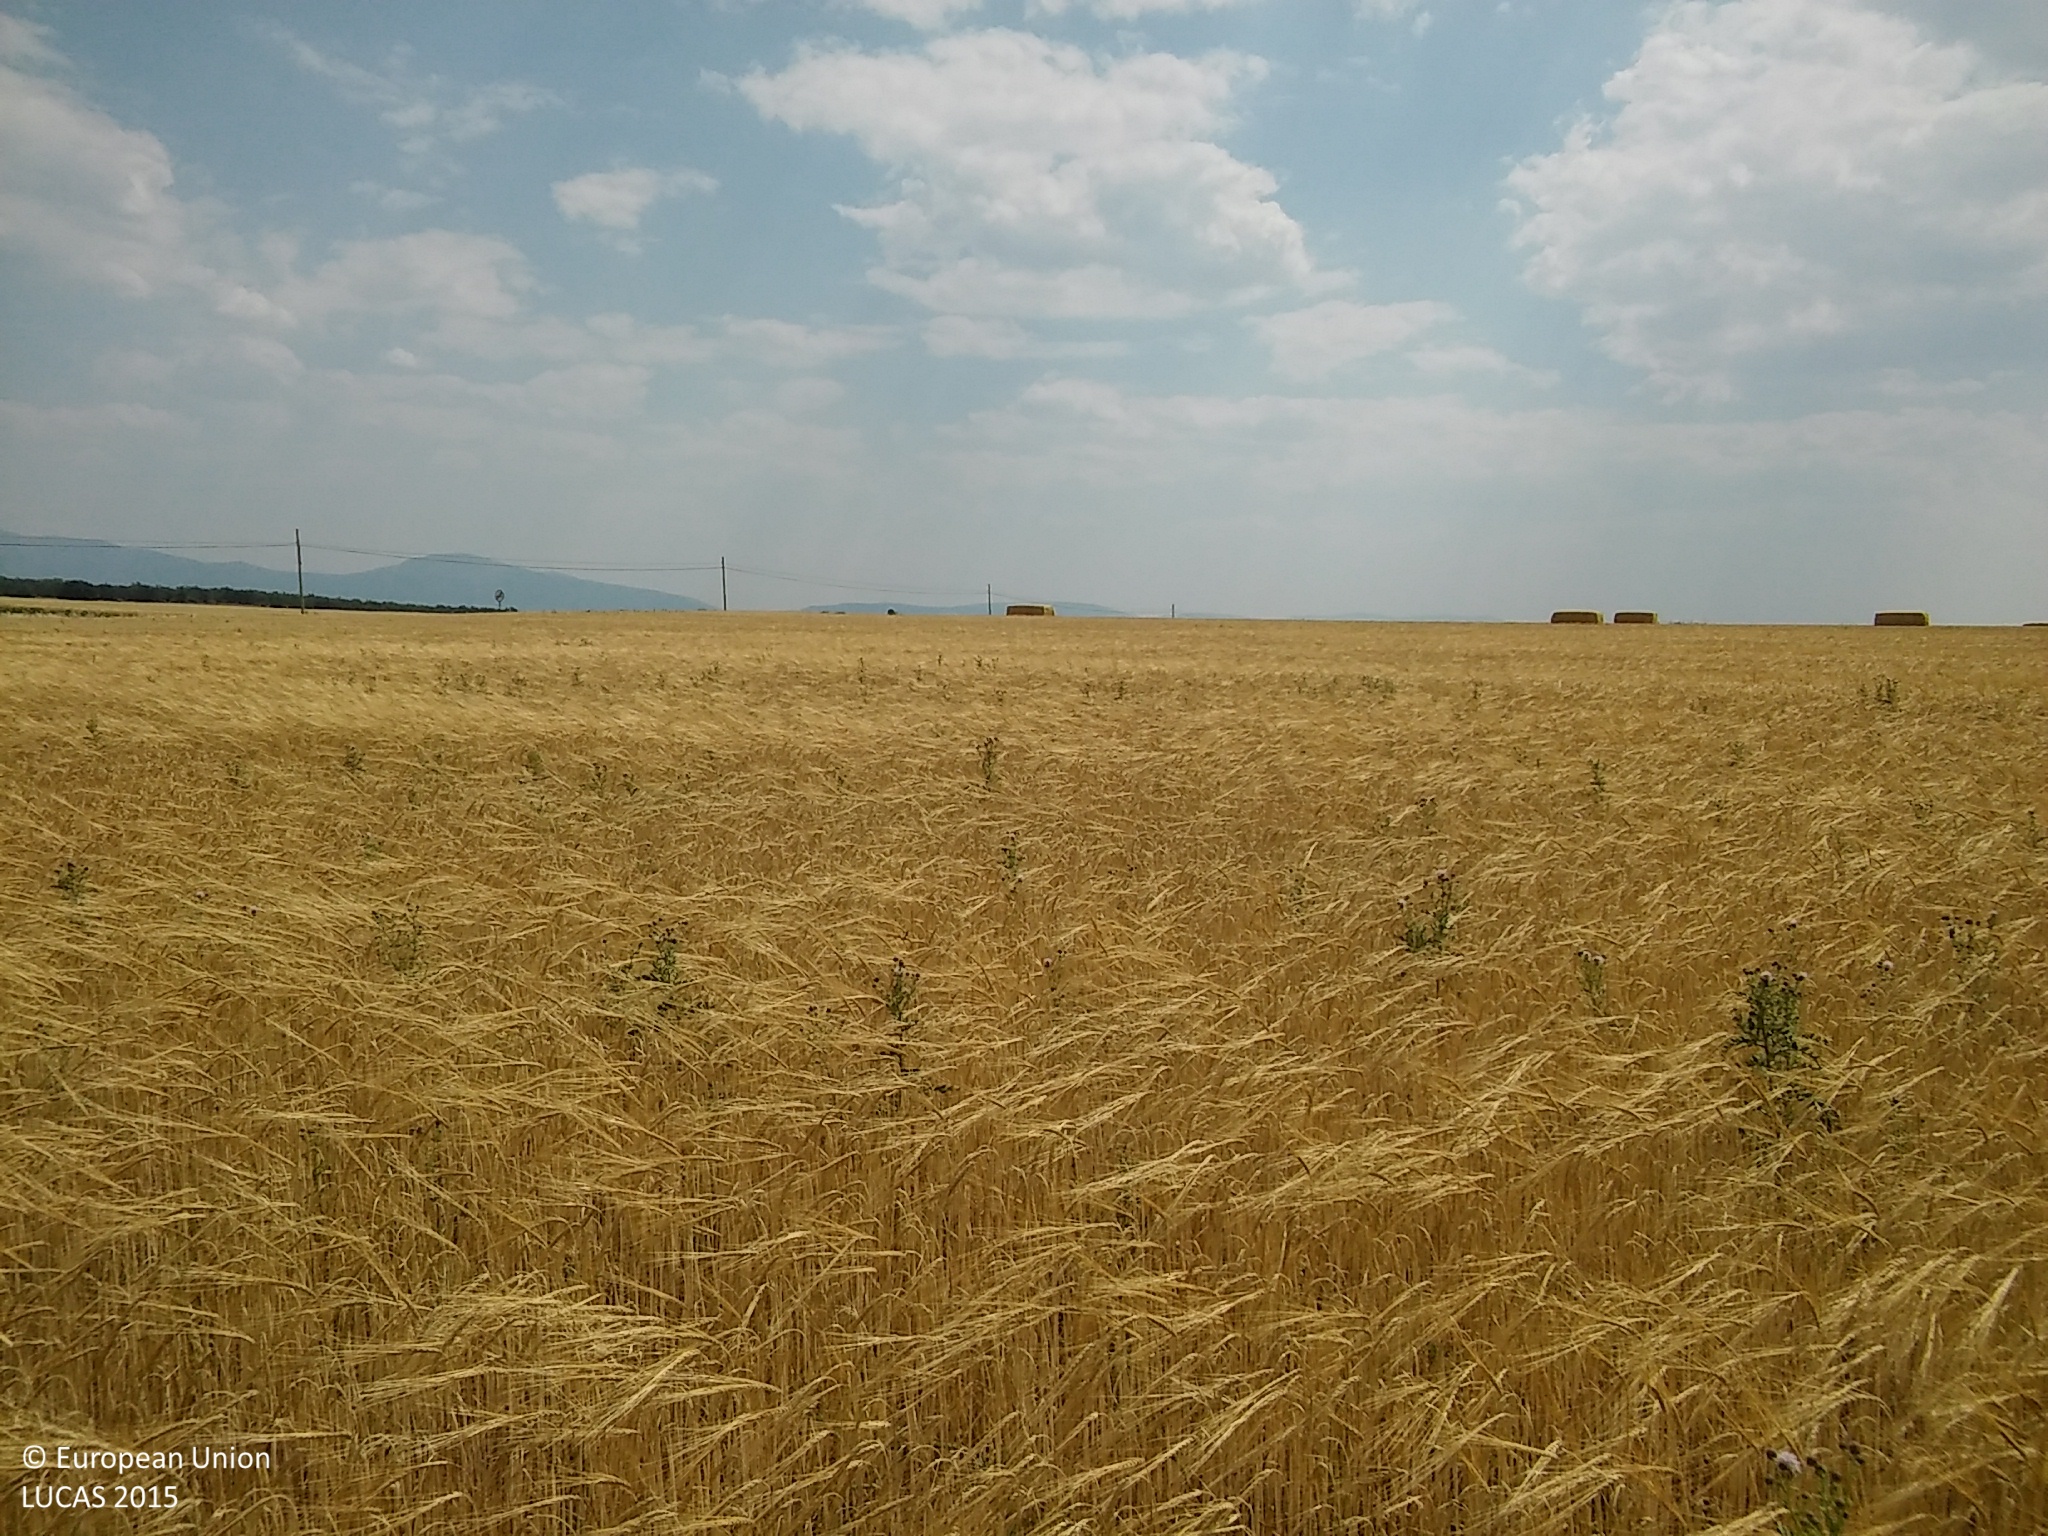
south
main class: Cropland
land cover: Barley
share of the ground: > 75 %
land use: Agriculture (excluding fallow land and kitchen gardens)
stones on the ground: 10 - 25 %
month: June
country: ES
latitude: 41.3848
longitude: -3.5969
